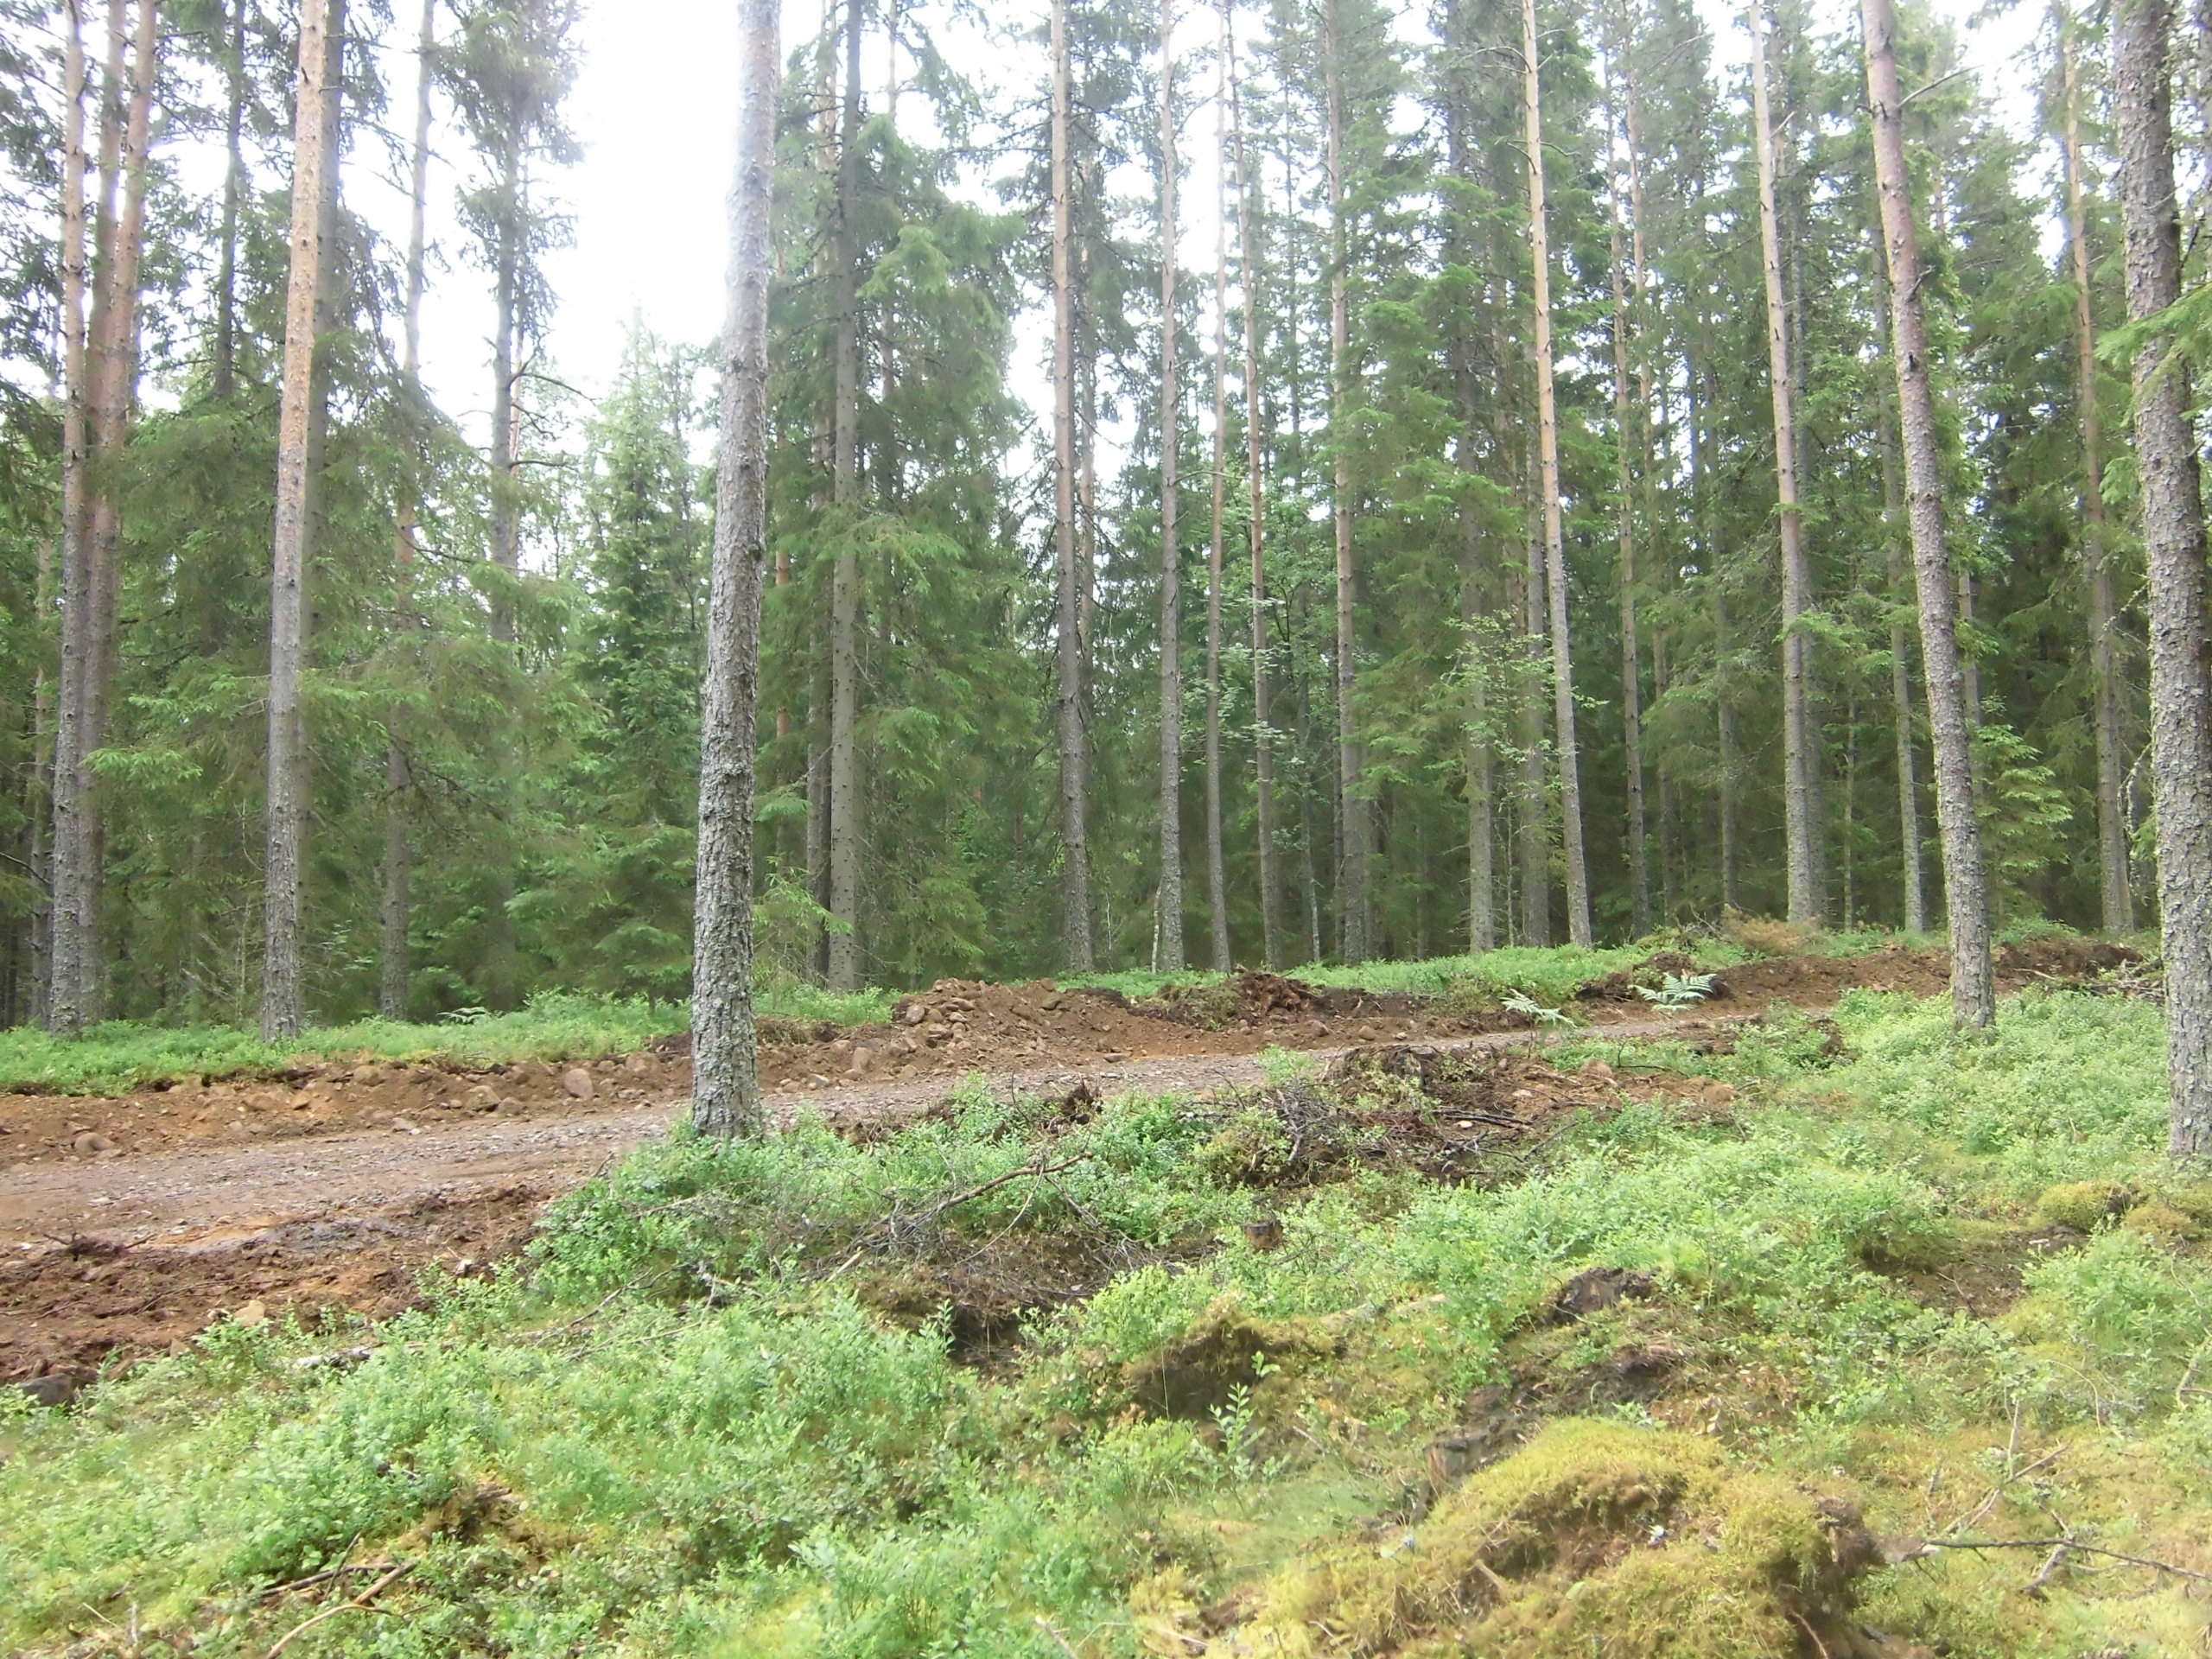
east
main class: Woodland
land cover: Pine dominated coniferous woodland
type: boreal forest
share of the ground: 25 - 50 %
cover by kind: coniferous forest trees 45 %, shrubs 25 %, lichens and mosses 15 %, herbaceous plants 10 %, broadleaved forest trees 5 %
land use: Forestry
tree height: > 5 m
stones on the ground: 10 - 25 %
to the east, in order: Pine dominated coniferous woodland; Tracks; Pine dominated coniferous woodland; Spruce dominated coniferous woodland; Ditches and canals; Spruce dominated coniferous woodland; Pine dominated coniferous woodland; Paved roads, cycling and walking lanes; Pine dominated coniferous woodland
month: July
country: SE
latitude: 57.3183
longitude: 14.9280
